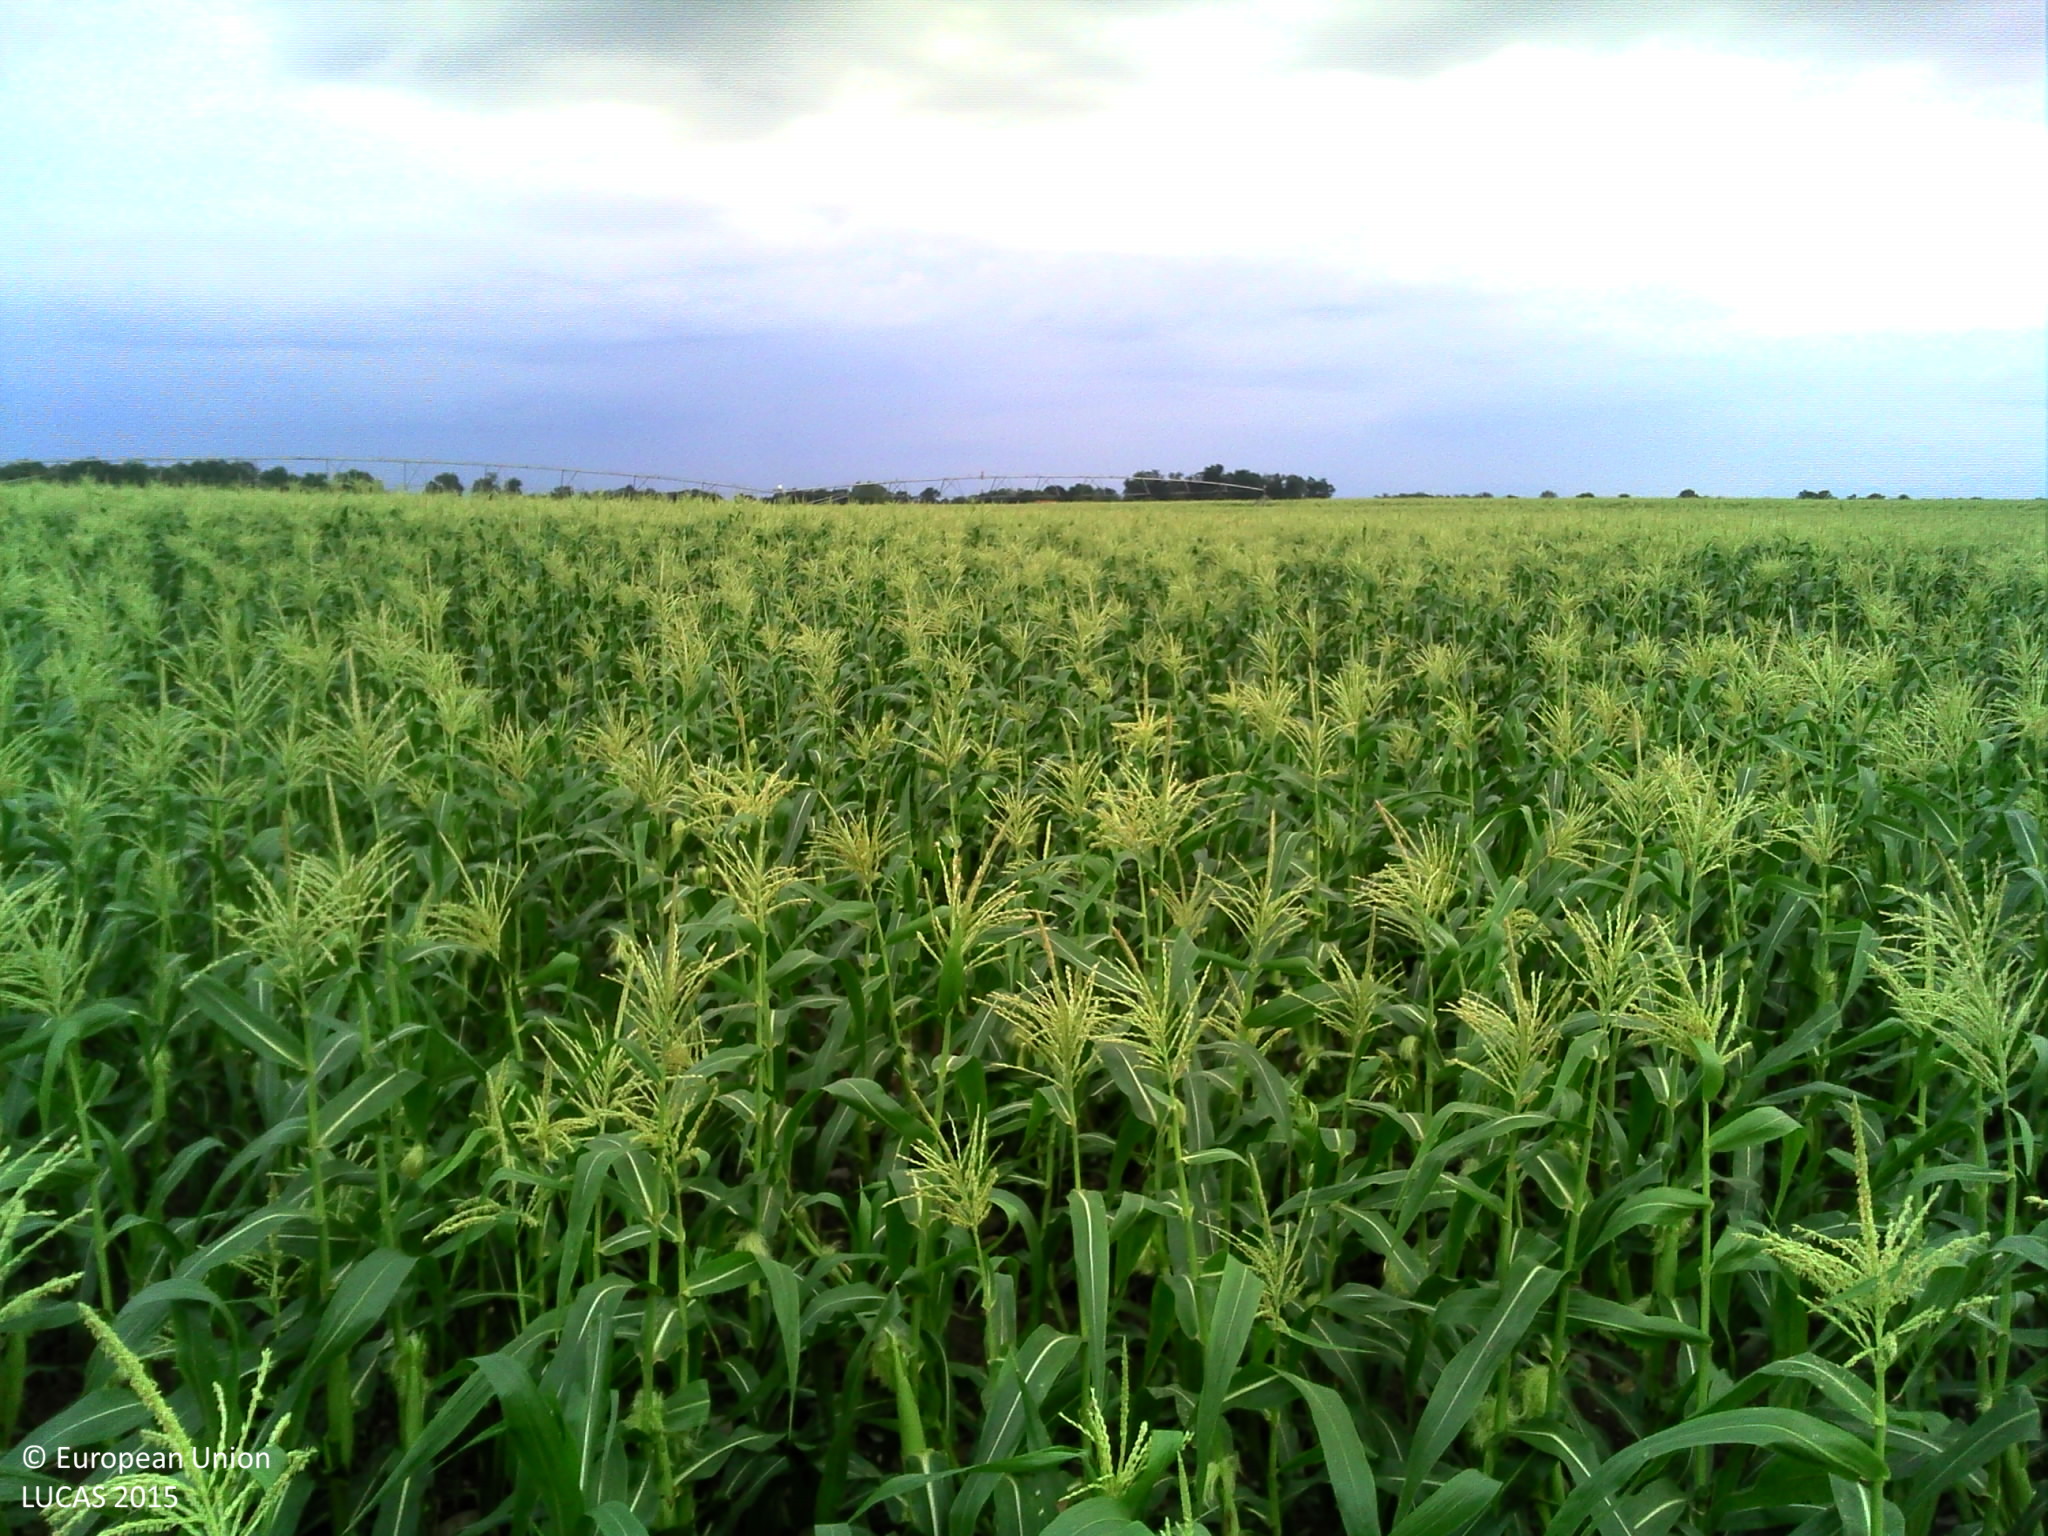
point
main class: Cropland
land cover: Maize
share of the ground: > 75 %
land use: Agriculture (excluding fallow land and kitchen gardens)
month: September
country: FR
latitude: 43.4067
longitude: -0.4177
